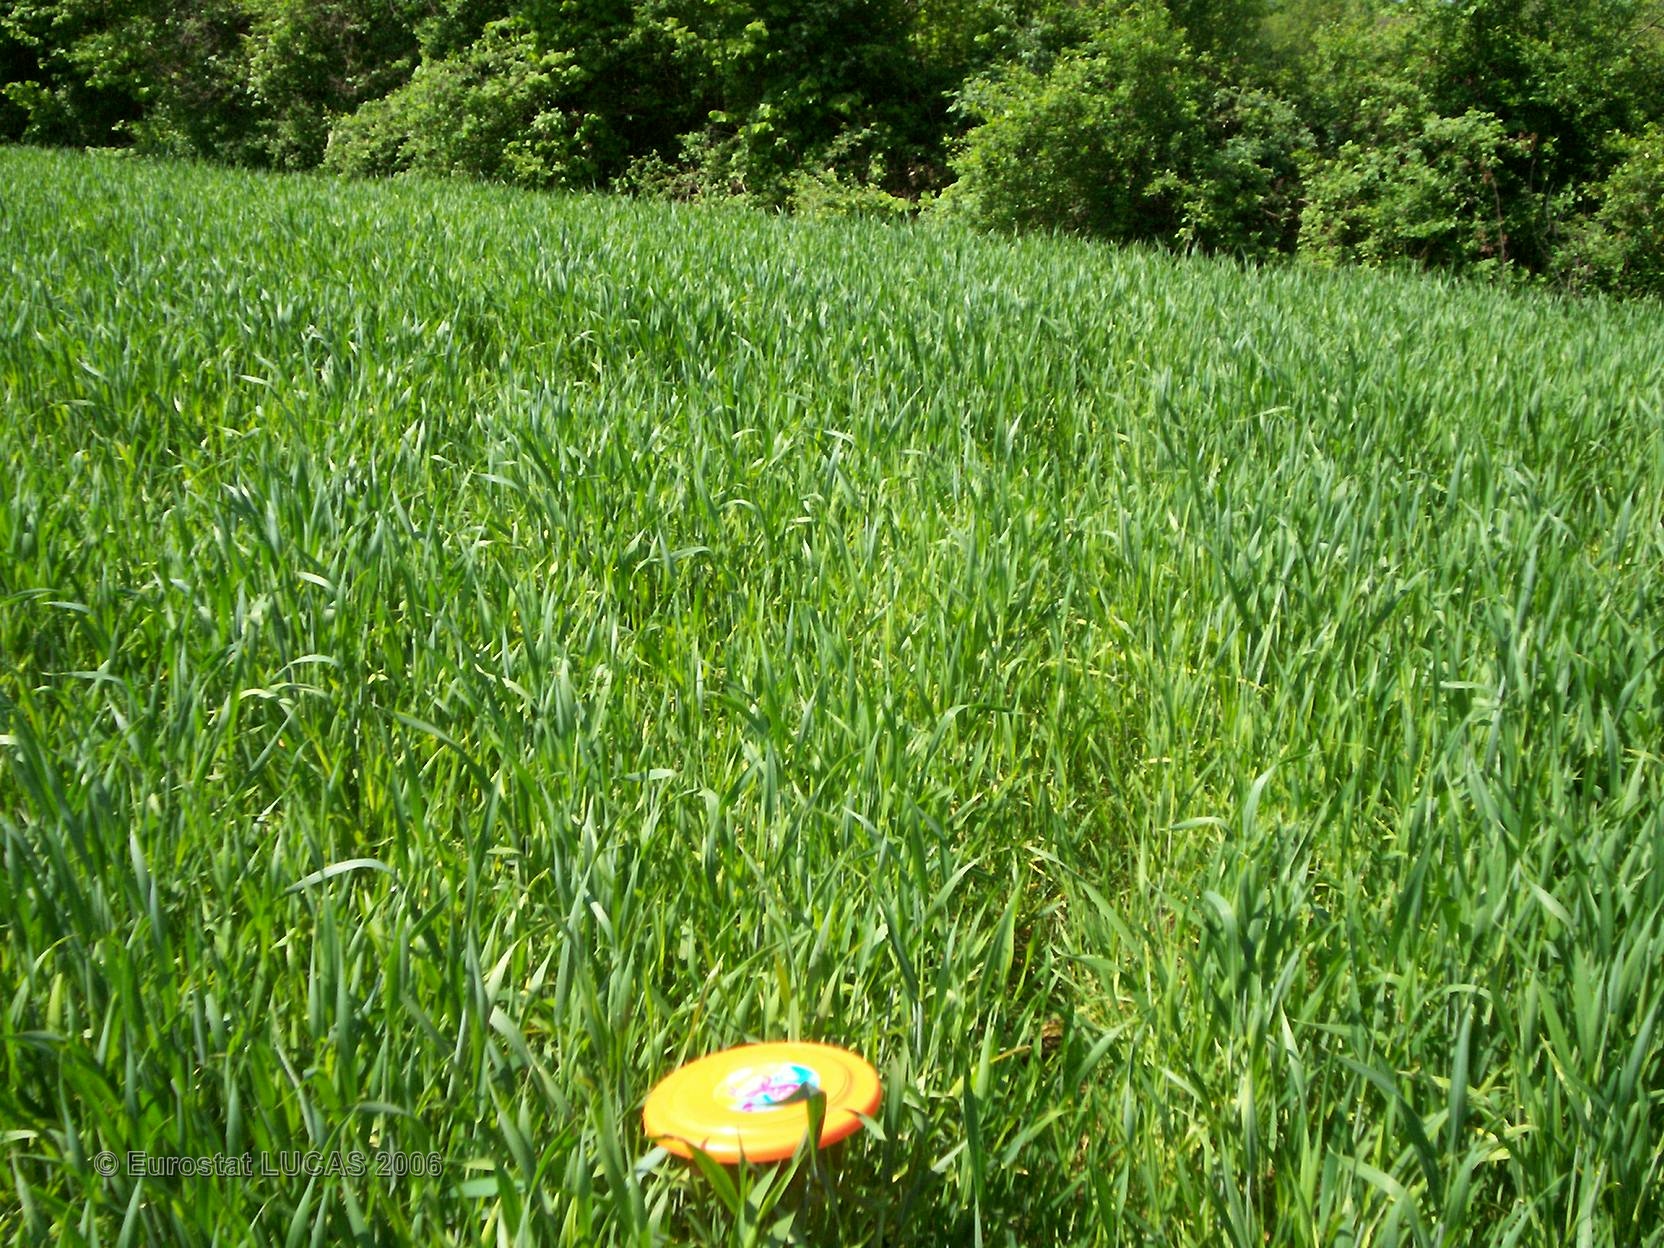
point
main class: Cropland
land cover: Common wheat
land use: Agriculture (excluding fallow land and kitchen gardens)
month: May
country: FR
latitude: 45.4409
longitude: 5.4152
